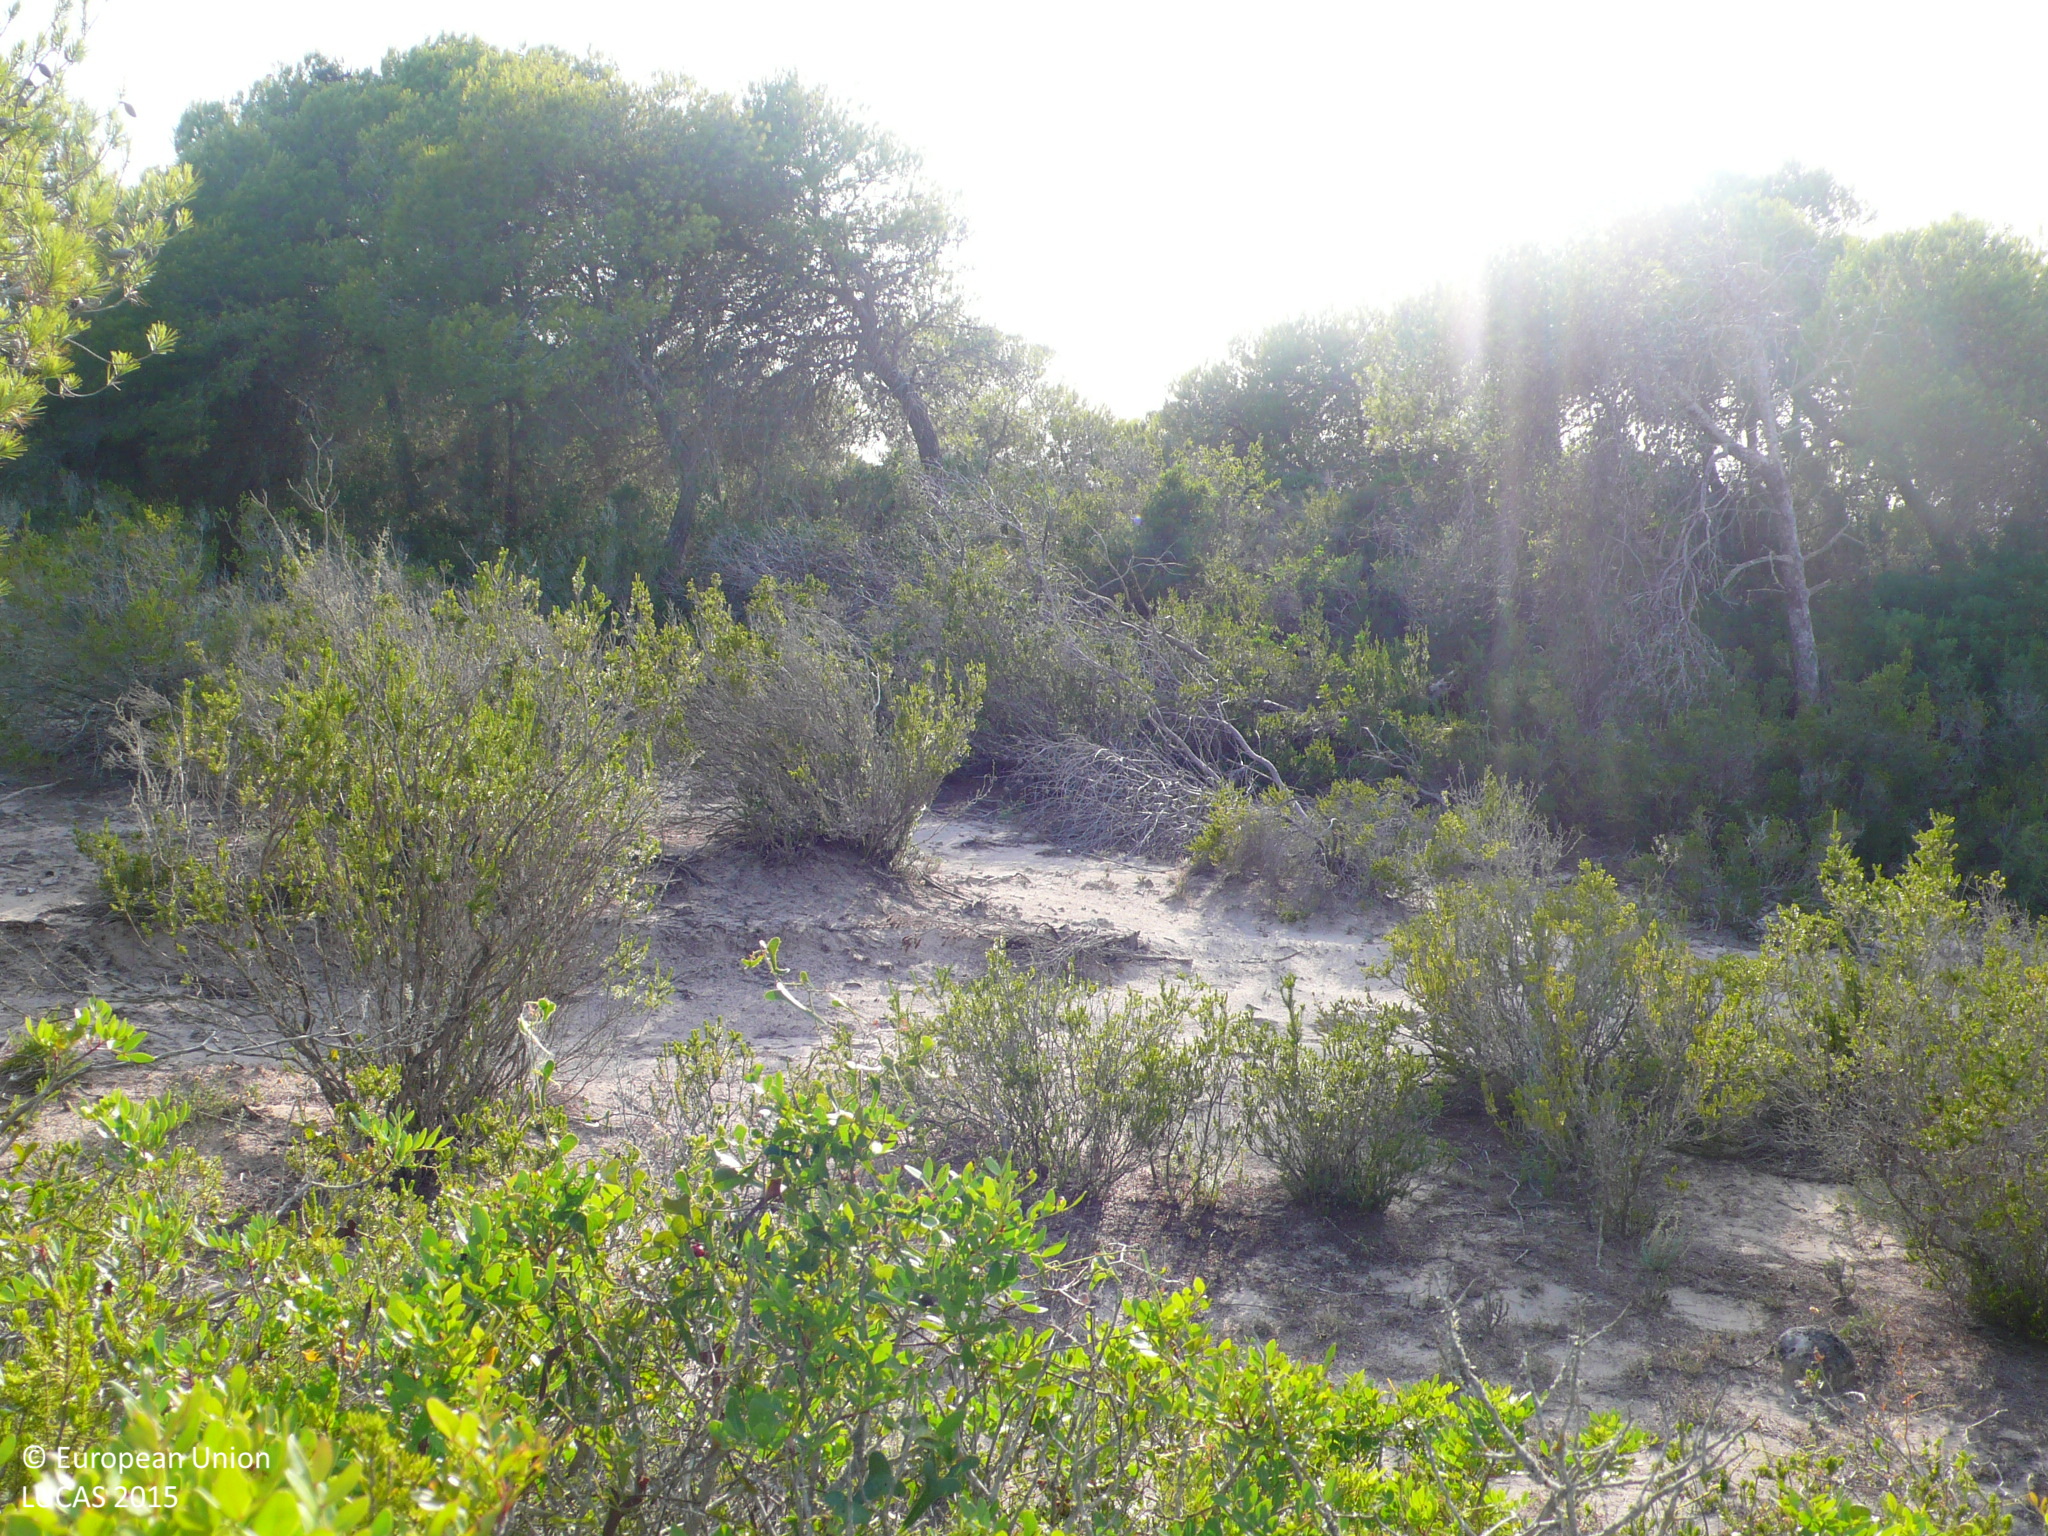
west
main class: Woodland
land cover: Pine dominated coniferous woodland
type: coniferous forest of the mediterranean region
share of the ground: 50 - 75 %
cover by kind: coniferous forest trees 45 %, shrubs 30 %, unconsolidated bare surface 25 %
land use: Semi-natural and natural areas not in use
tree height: > 5 m
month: July
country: ES
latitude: 39.7260
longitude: 3.2505
